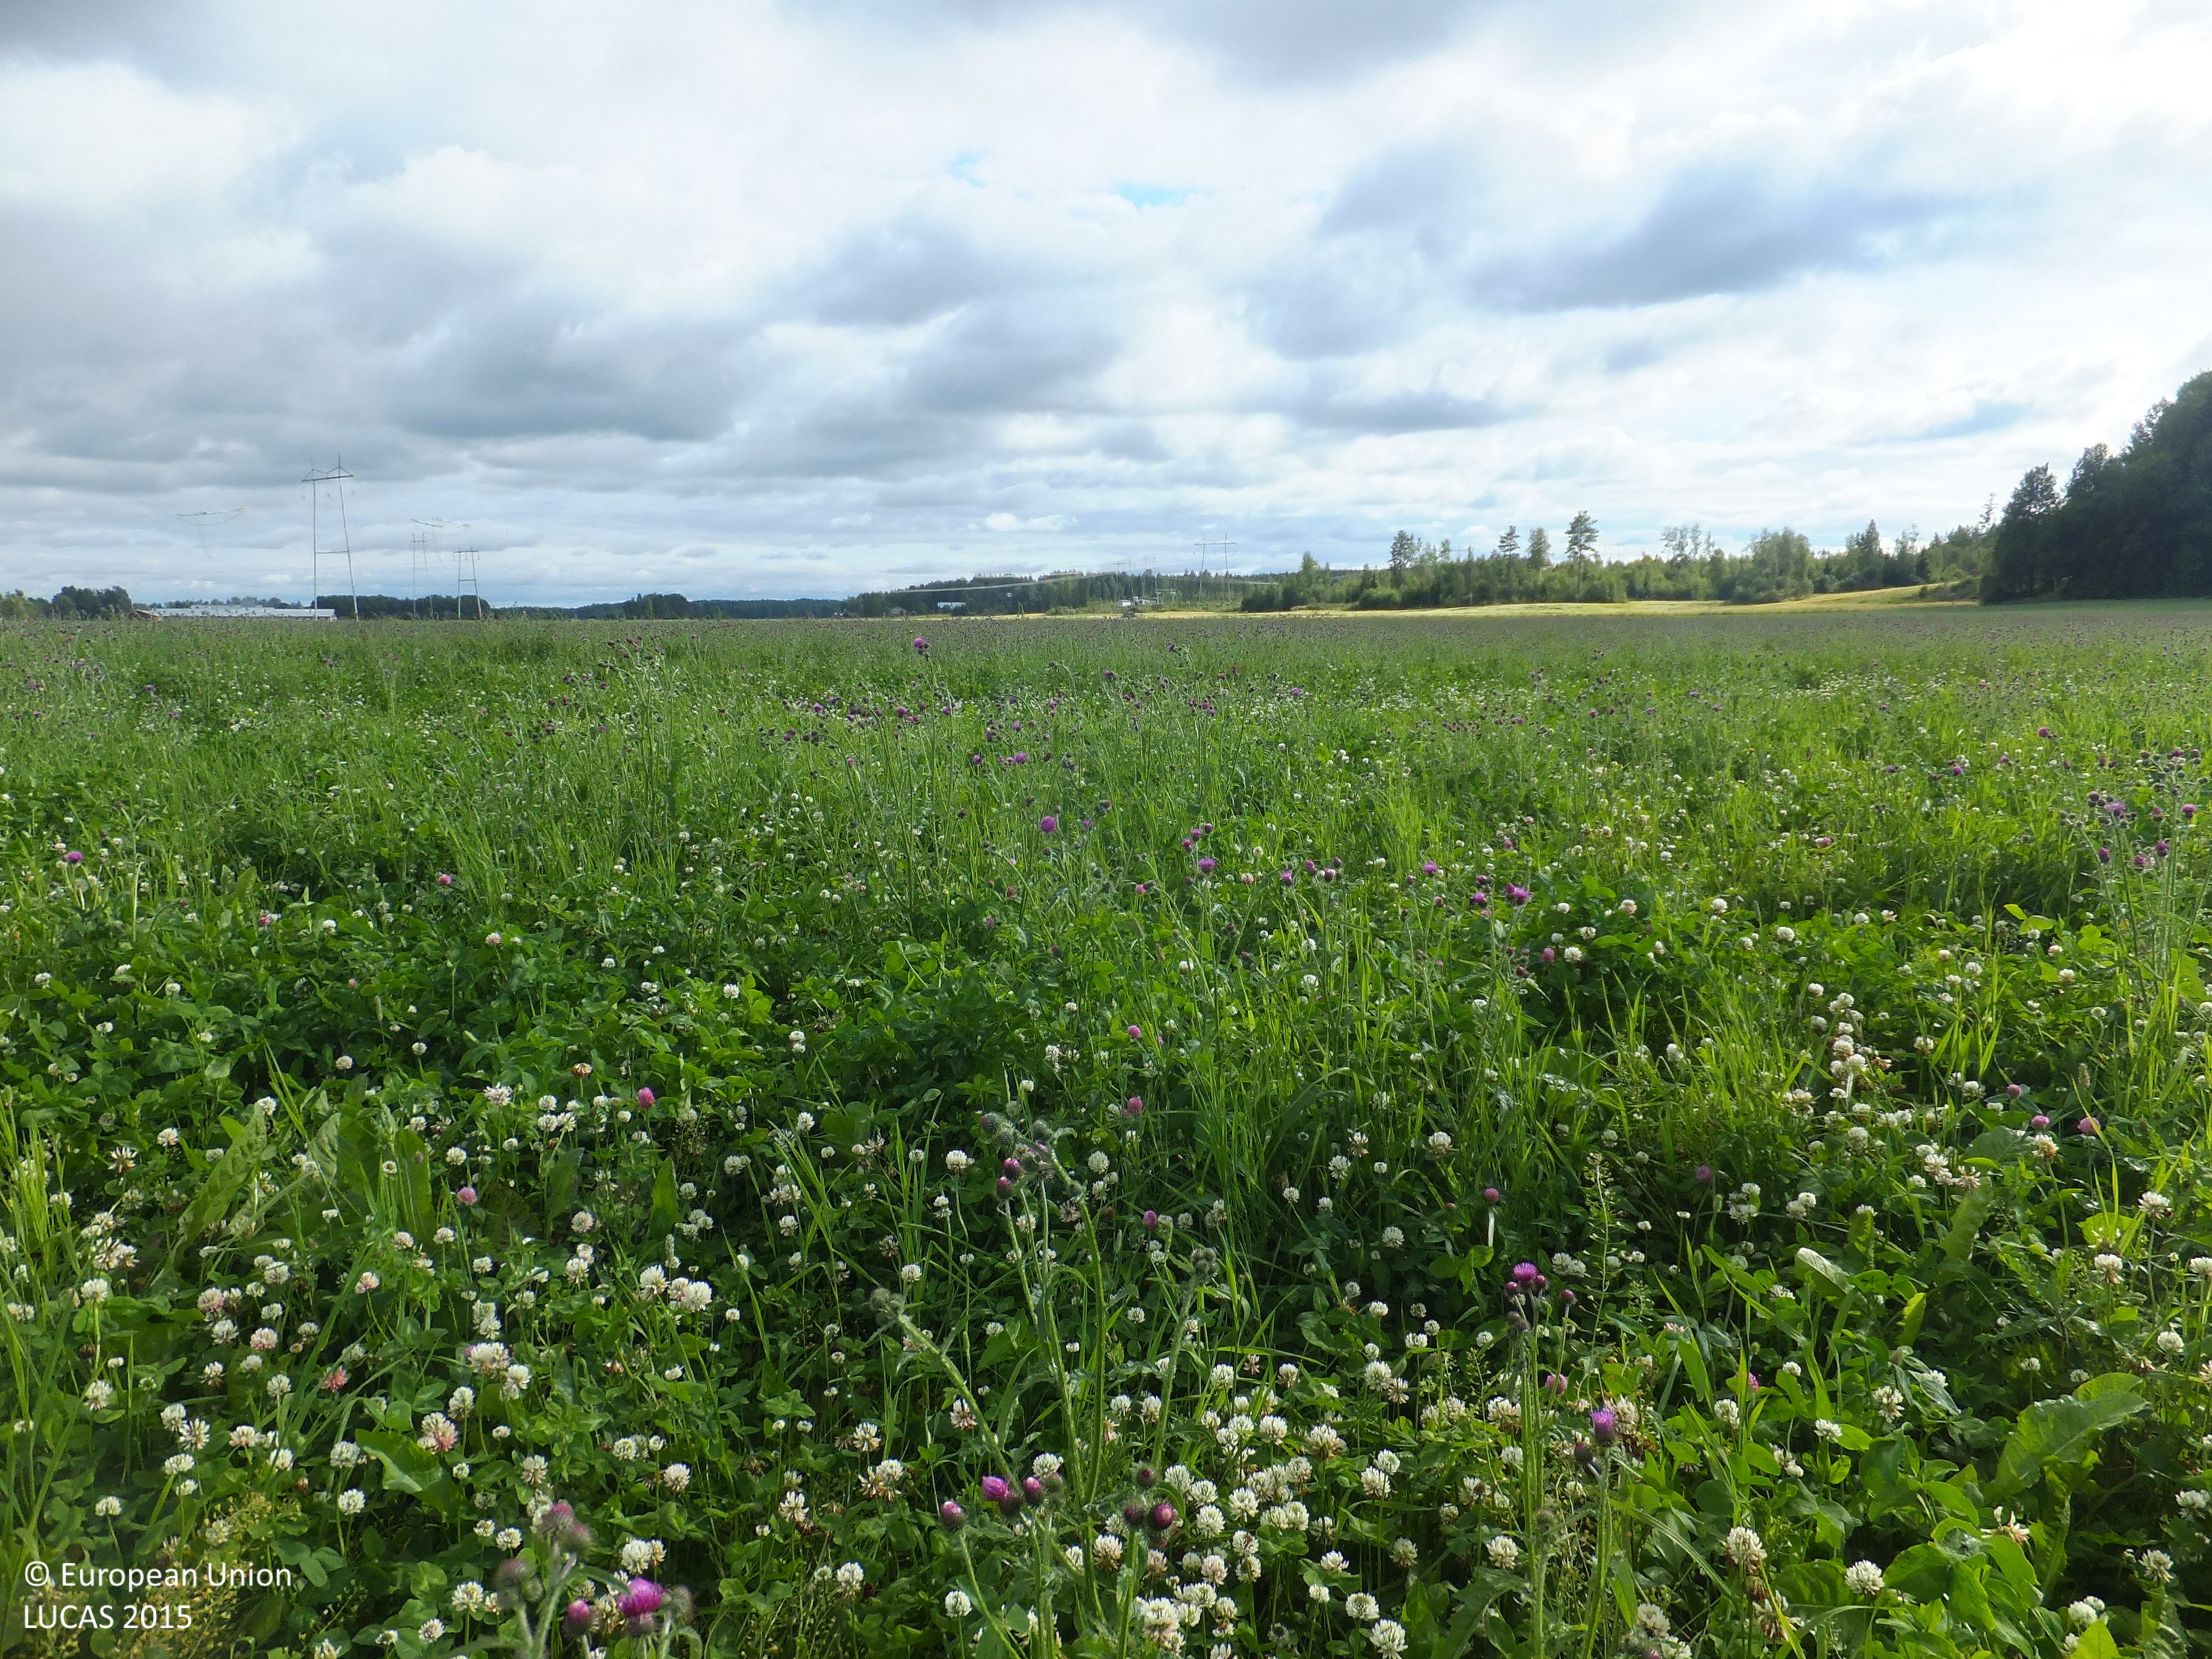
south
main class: Cropland
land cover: Clovers
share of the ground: > 75 %
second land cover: Temporary grasslands
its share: 50 - 75 %
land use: Agriculture (excluding fallow land and kitchen gardens)
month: July
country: FI
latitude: 63.1942
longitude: 22.1900
